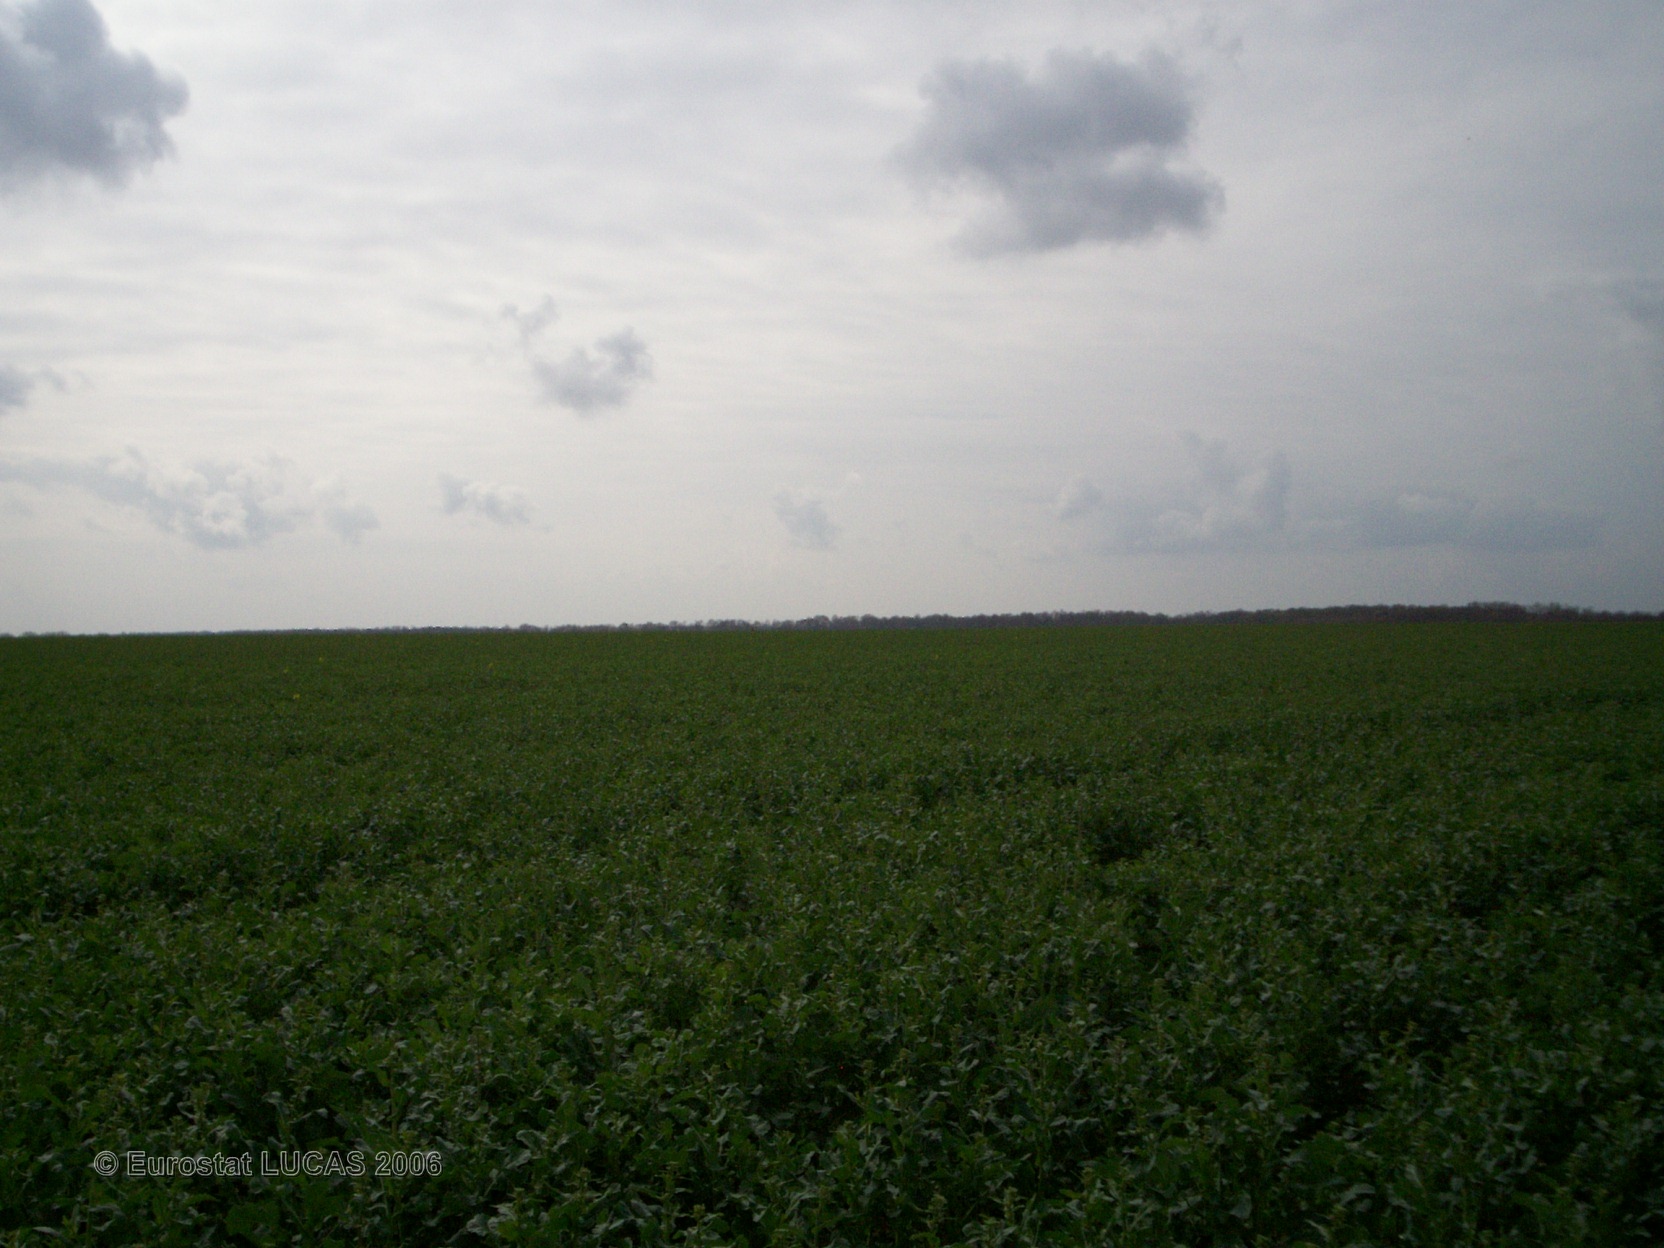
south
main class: Cropland
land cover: Rape and turnip rape
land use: Agriculture (excluding fallow land and kitchen gardens)
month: April
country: FR
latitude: 48.2632
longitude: 2.8655
